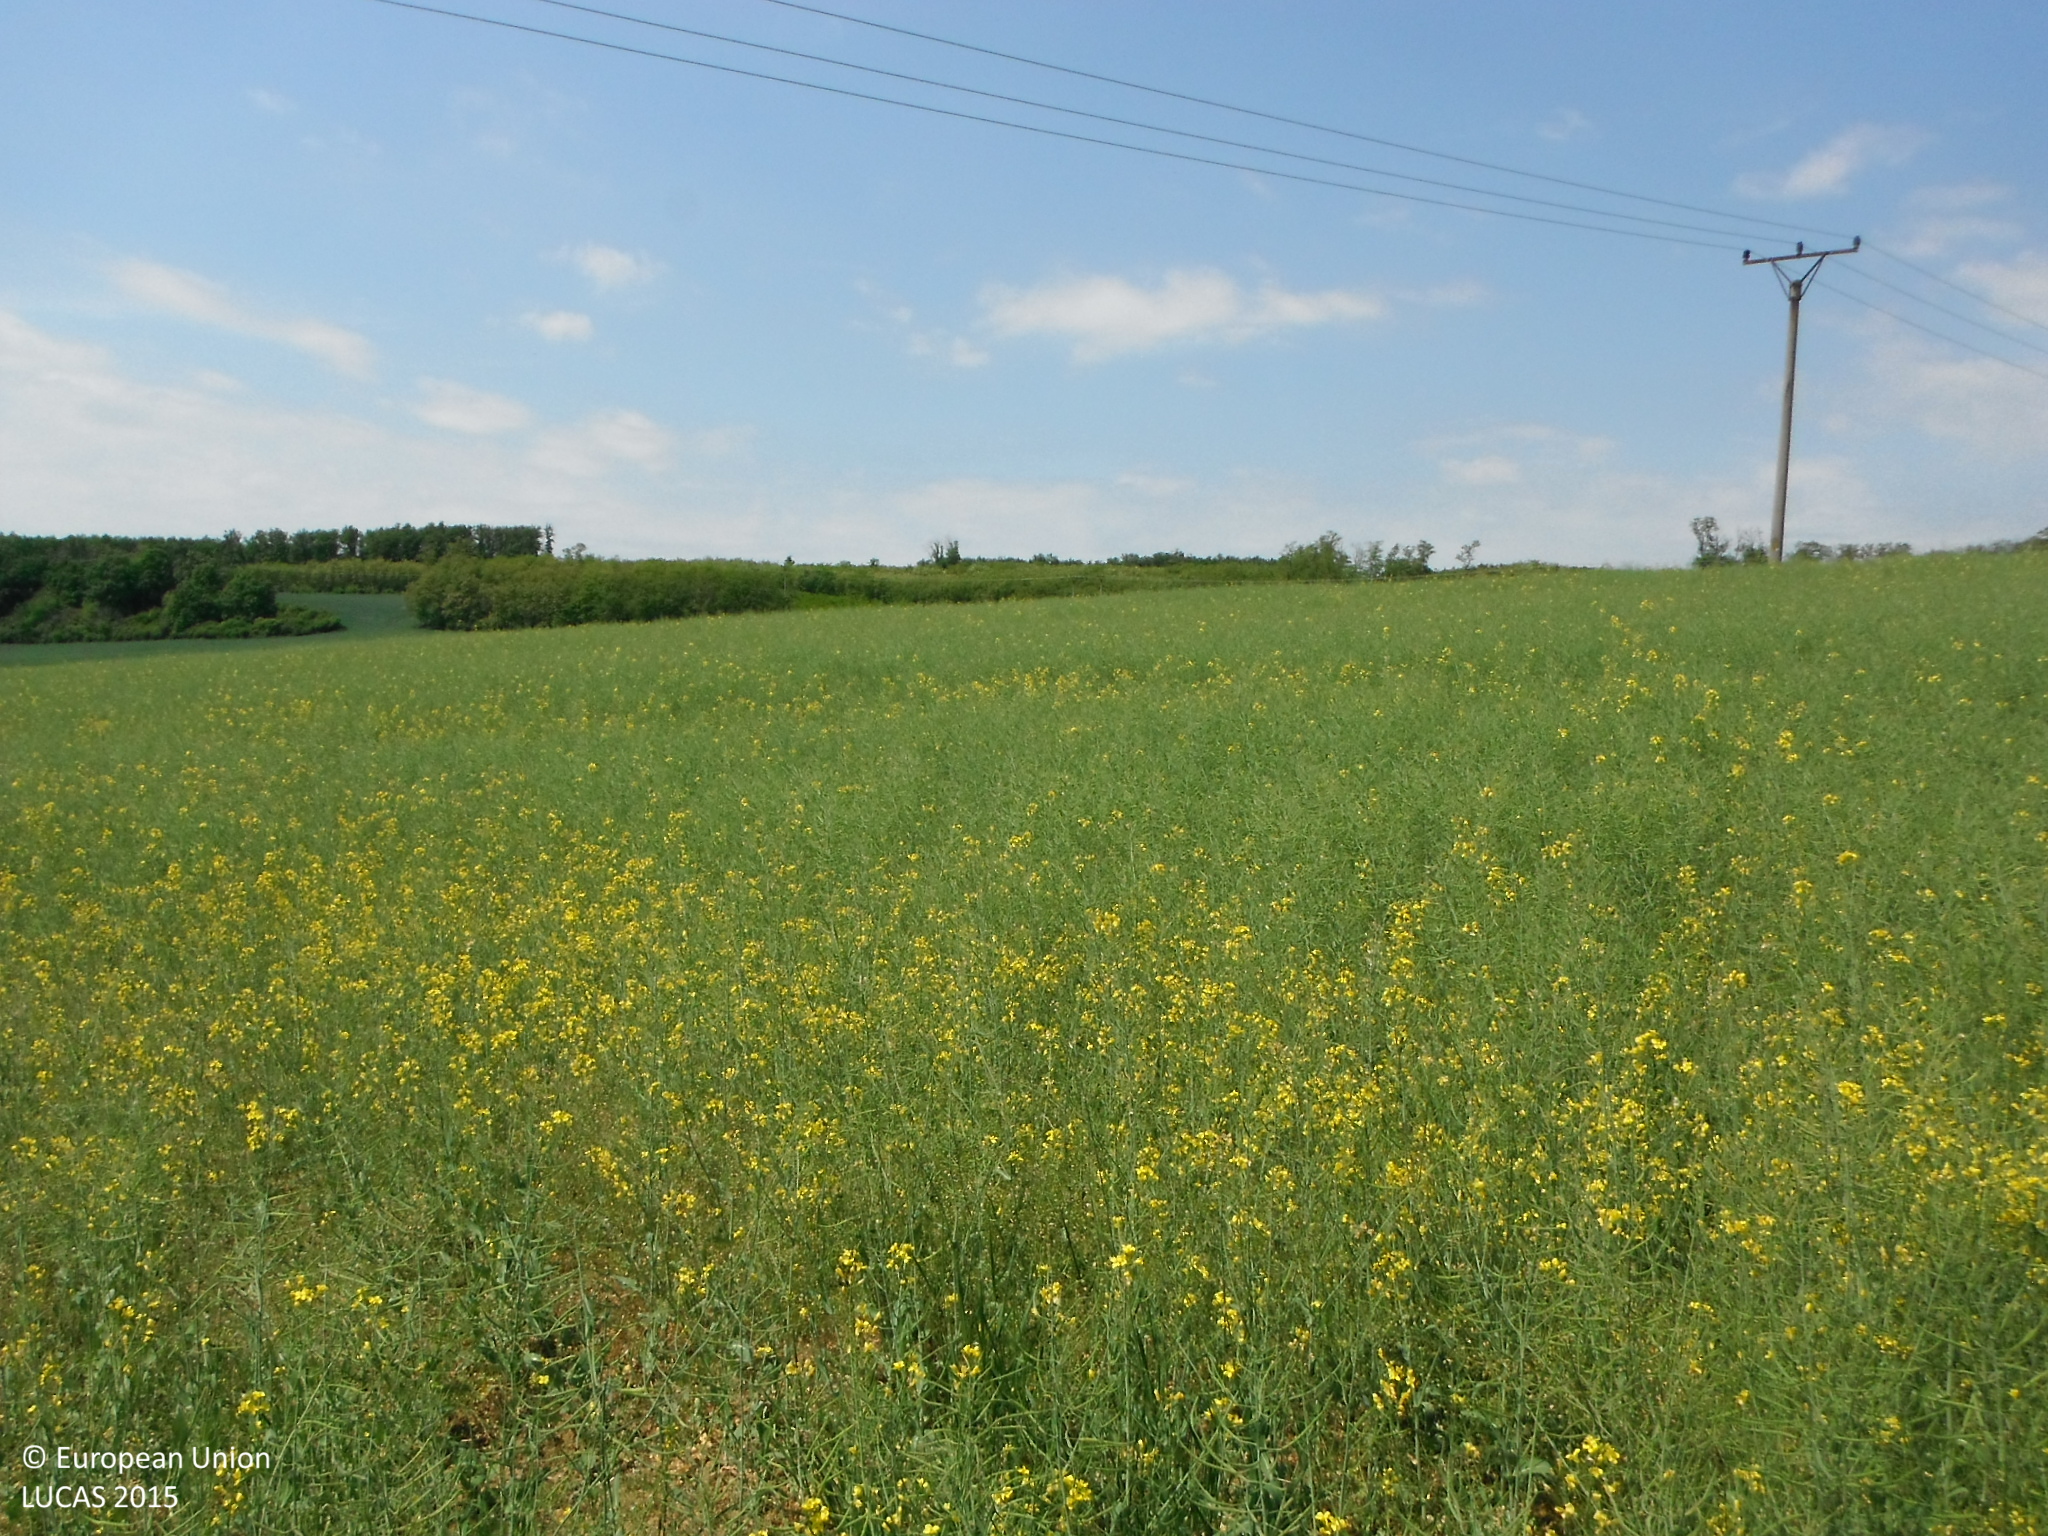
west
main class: Cropland
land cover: Rape and turnip rape
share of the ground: > 75 %
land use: Agriculture (excluding fallow land and kitchen gardens)
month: May
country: SK
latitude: 48.2953
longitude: 18.4678
